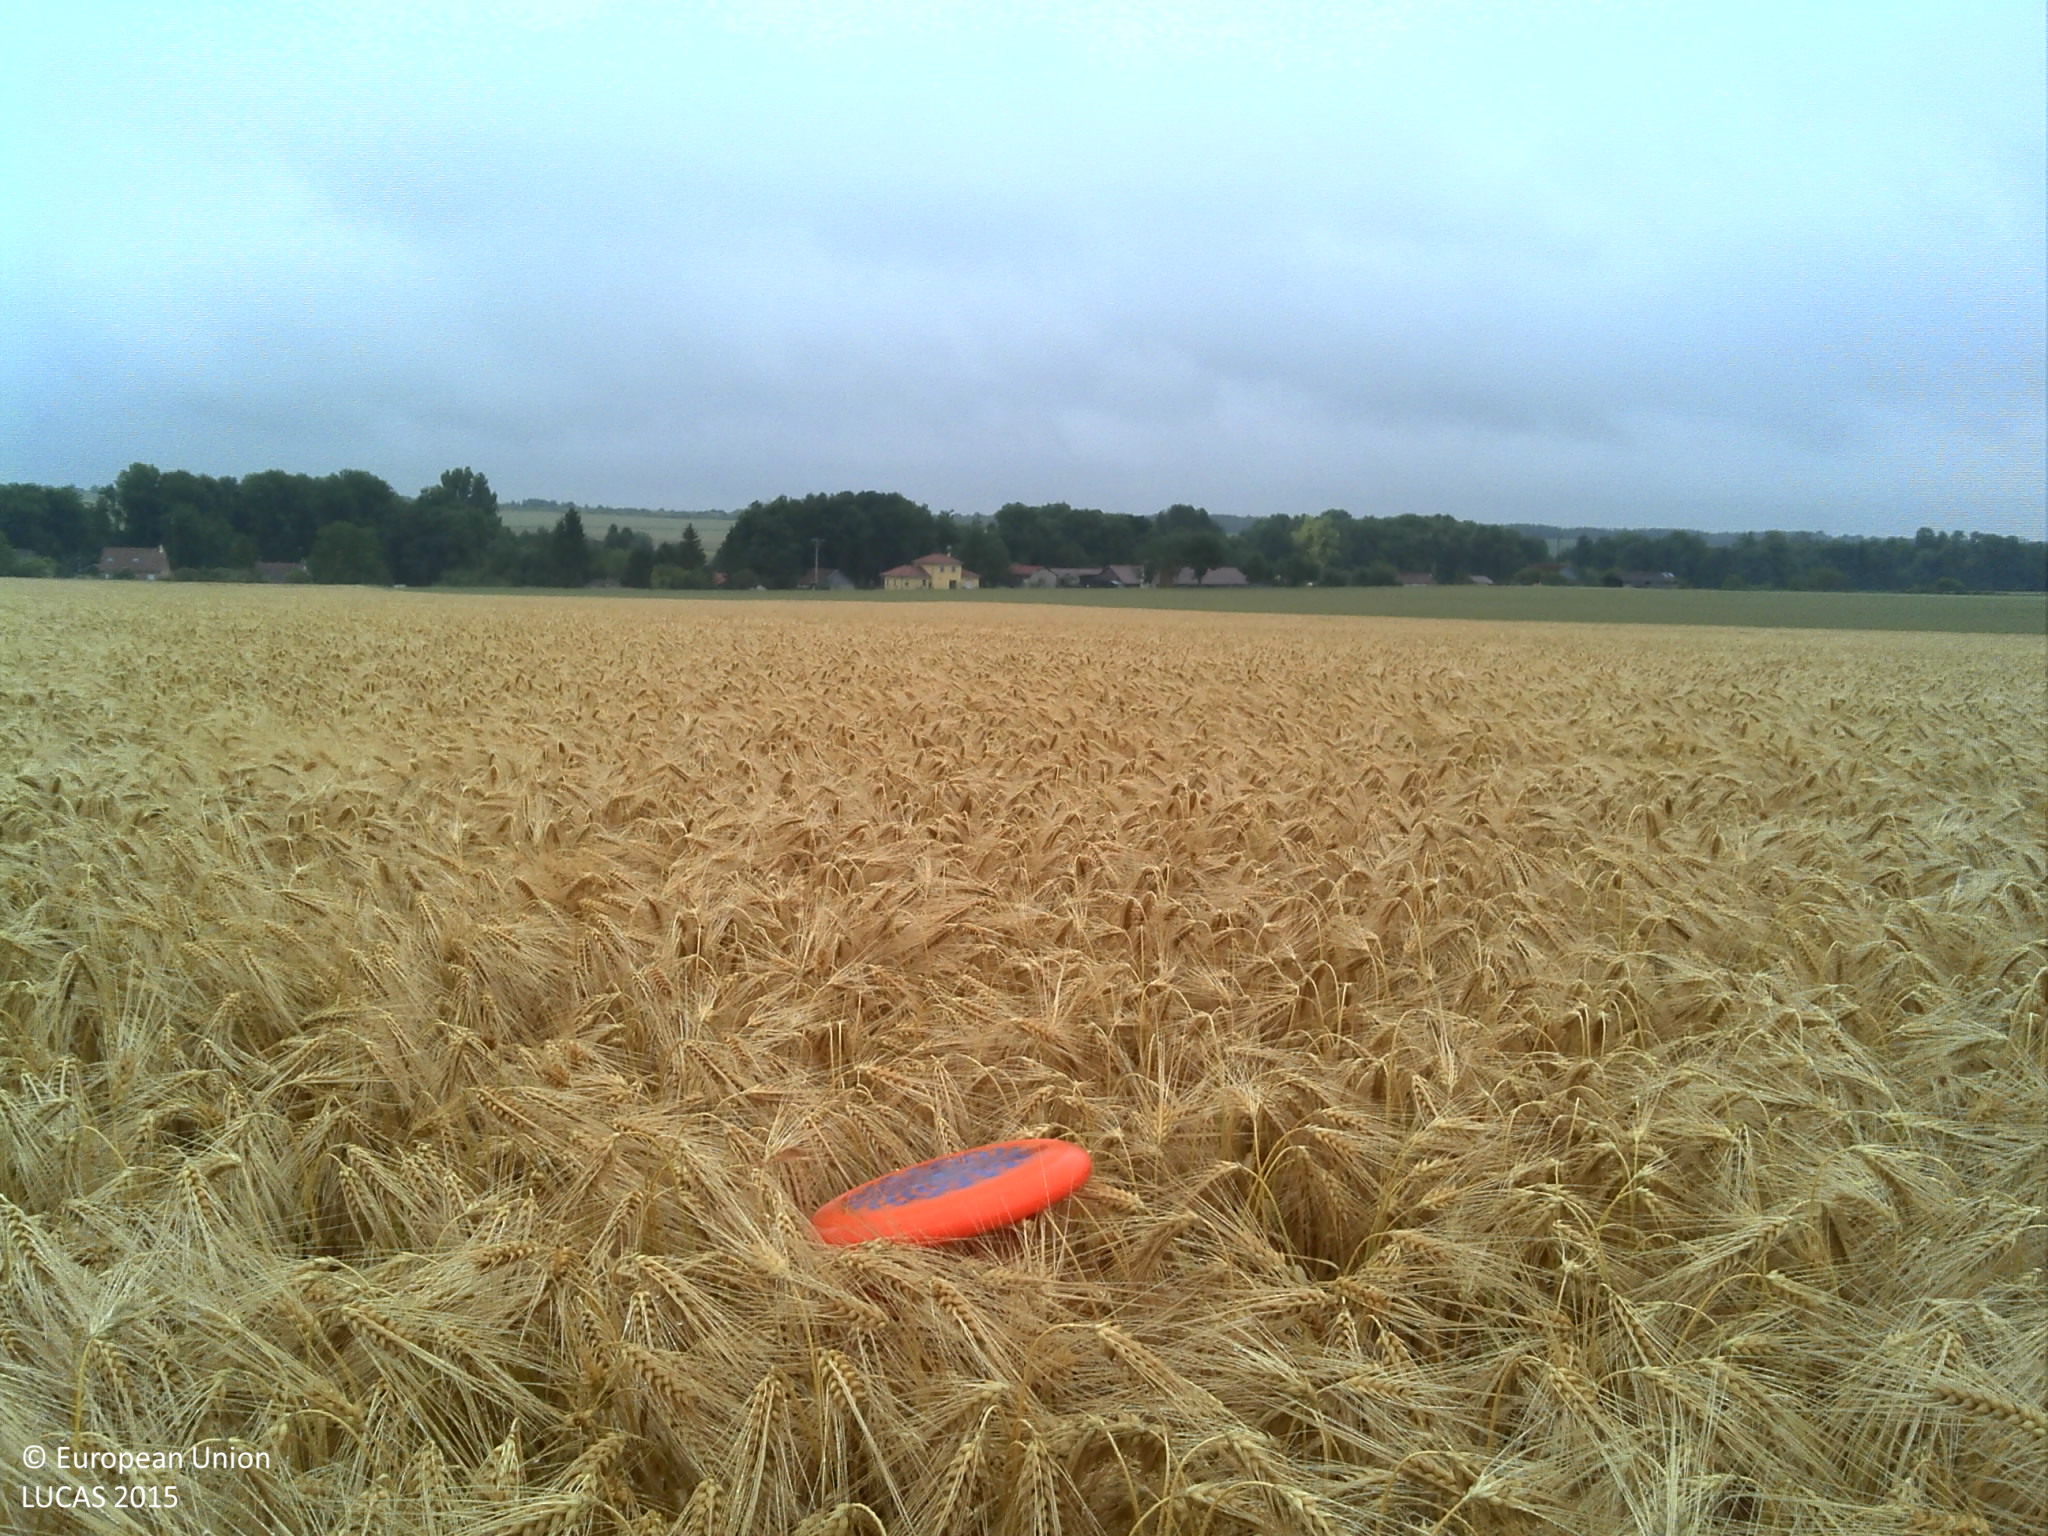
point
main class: Cropland
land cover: Common wheat
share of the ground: > 75 %
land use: Agriculture (excluding fallow land and kitchen gardens)
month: June
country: FR
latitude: 48.6868
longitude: 4.2504
